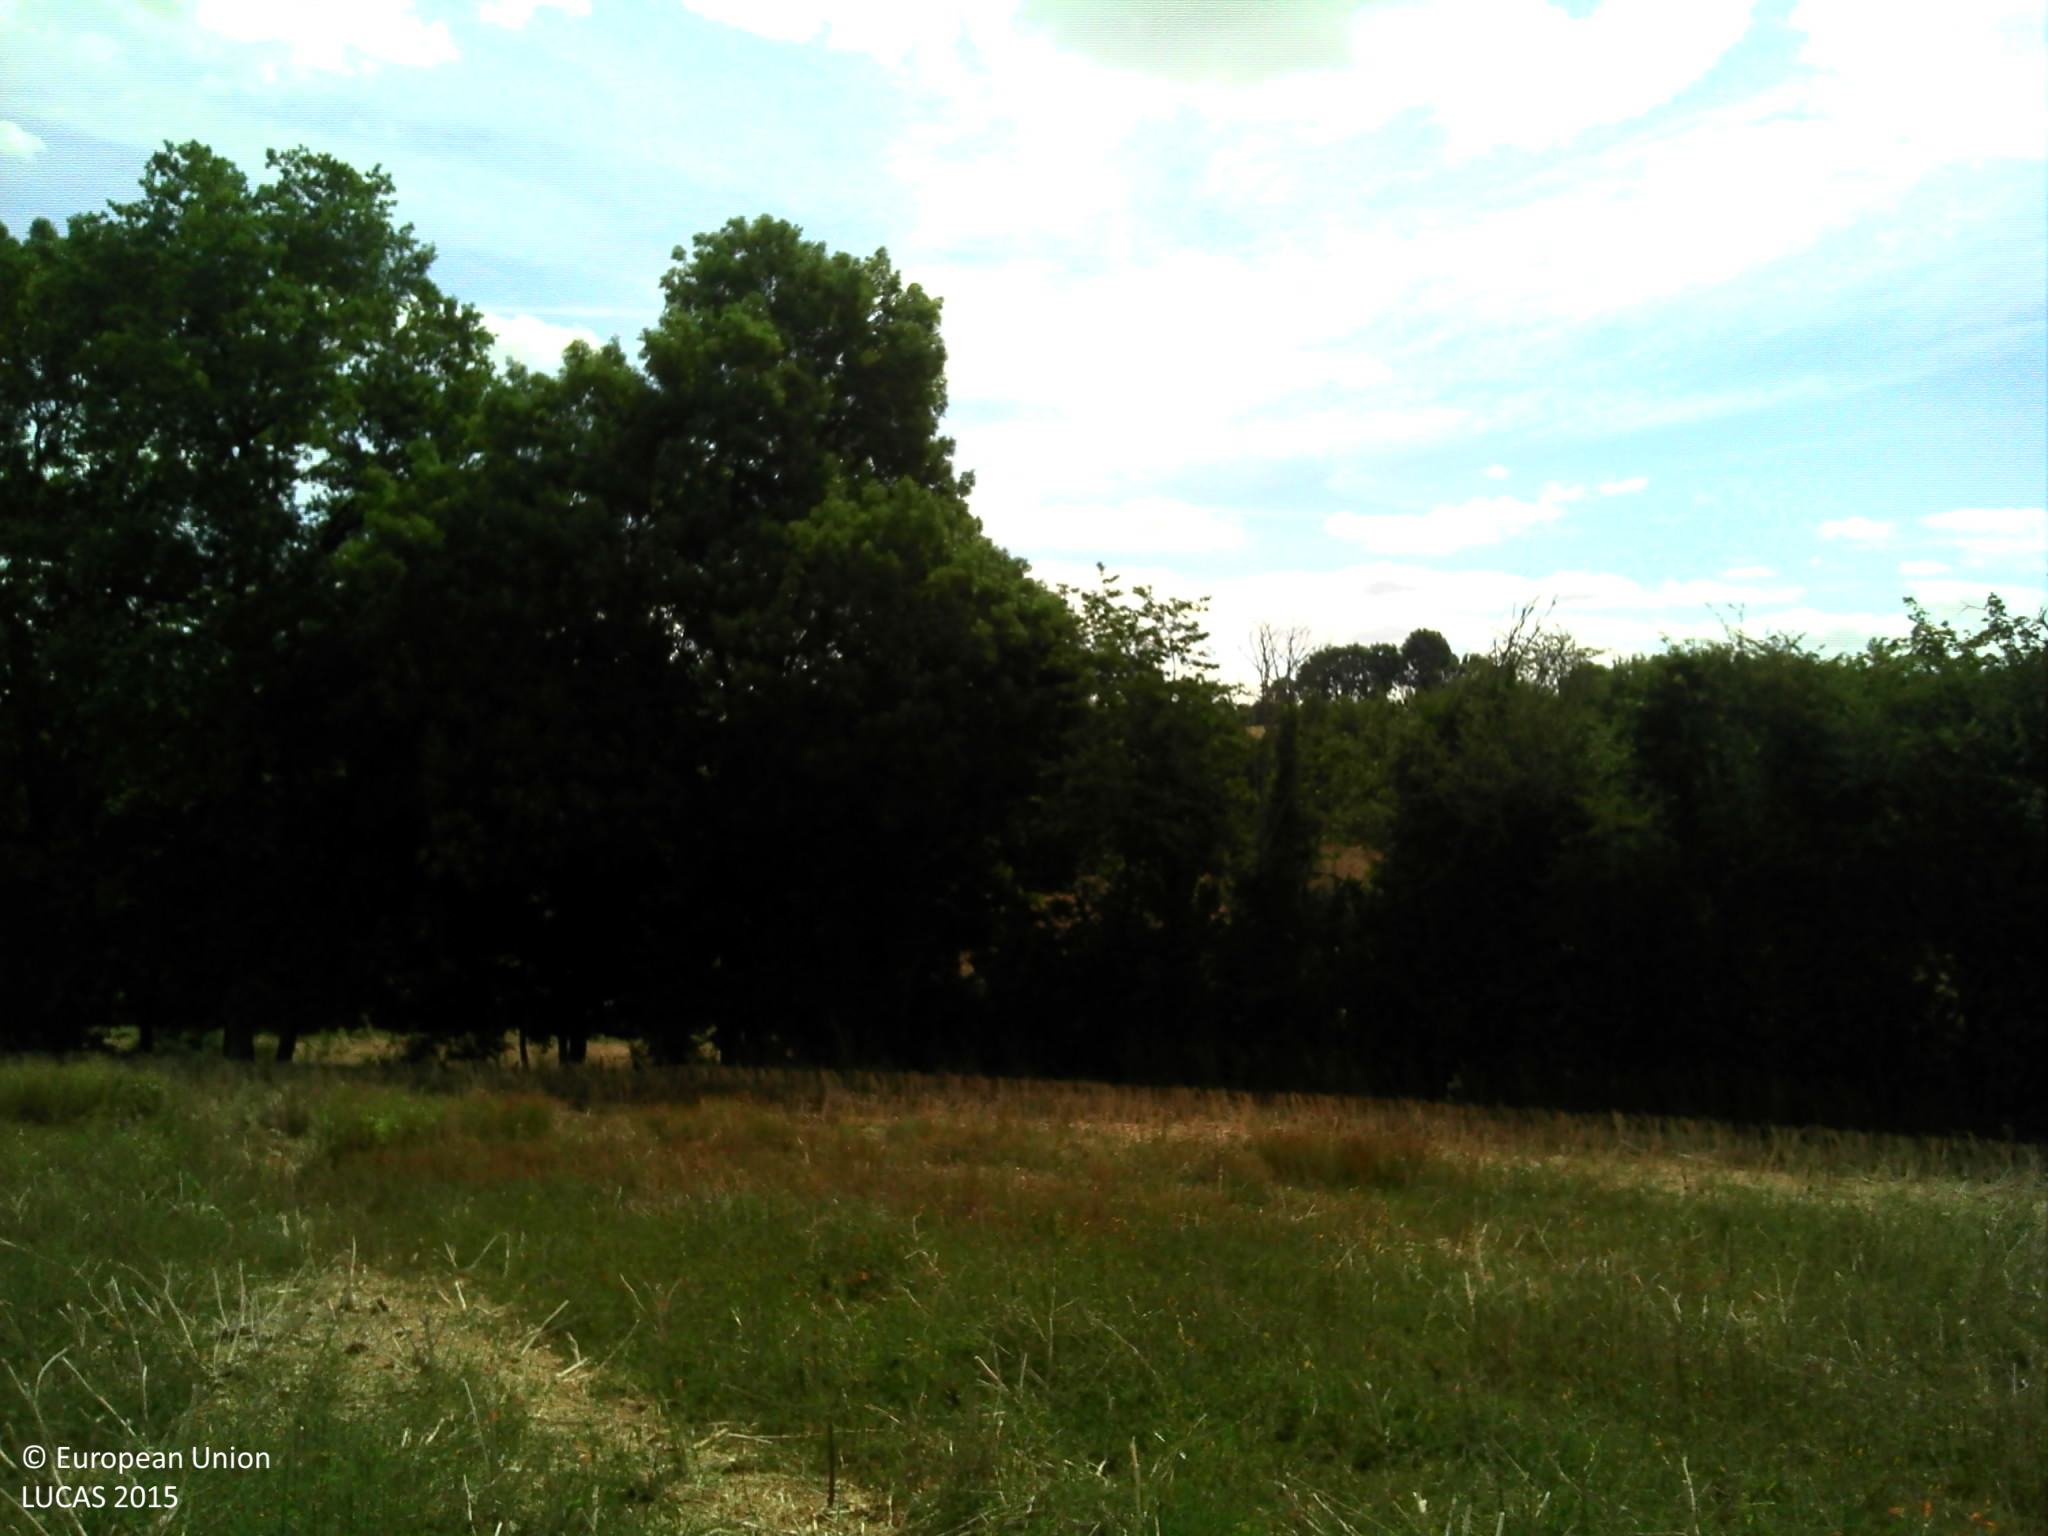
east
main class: Cropland
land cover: Rape and turnip rape
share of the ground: 25 - 50 %
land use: Agriculture (excluding fallow land and kitchen gardens)
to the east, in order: Rape and turnip rape; Broadleaved woodland; Fences; Grassland without tree/shrub cover; Rivers and streams; Fences; Lines of trees; Tracks; Lines of trees; Fences; Grassland without tree/shrub cover; Broadleaved woodland
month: July
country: FR
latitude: 47.8649
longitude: 0.6881
